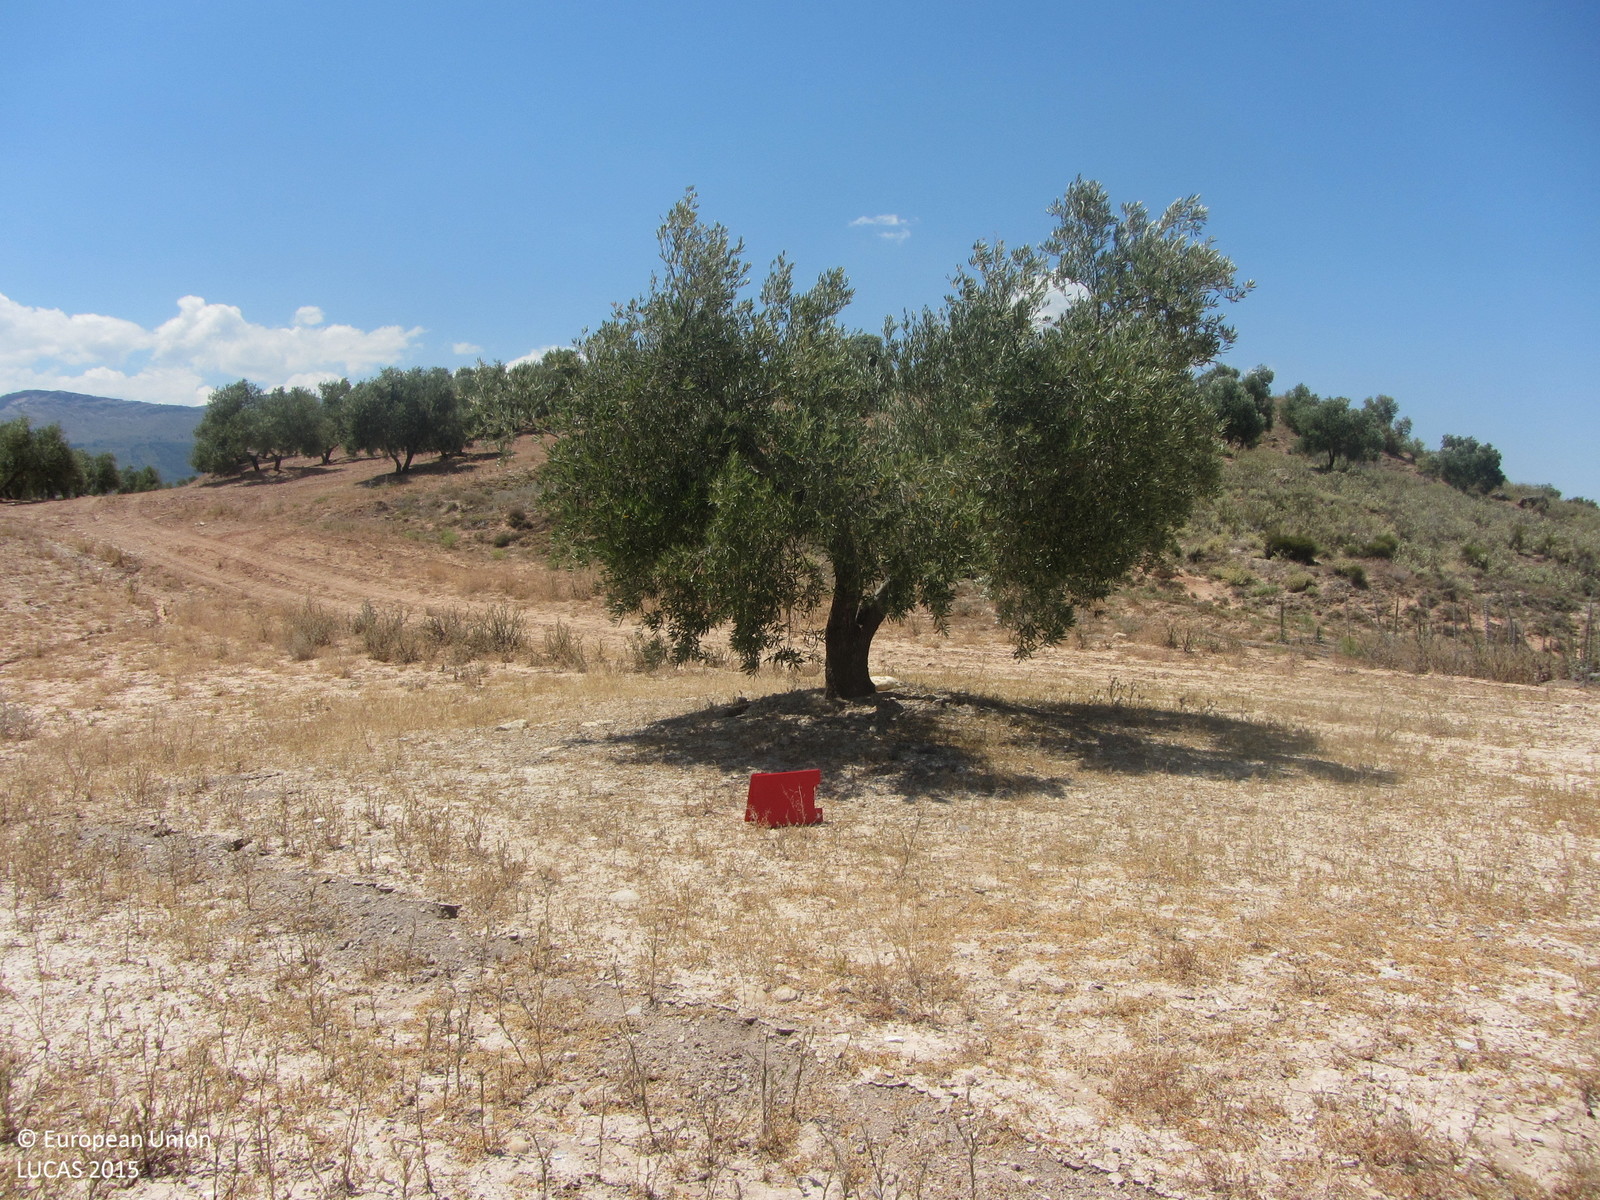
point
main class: Cropland
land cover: Olive groves
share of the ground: 10 - 25 %
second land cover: Spontaneously vegetated surfaces
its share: 10 - 25 %
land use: Agriculture (excluding fallow land and kitchen gardens)
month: June
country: ES
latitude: 37.8158
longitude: -3.8263
